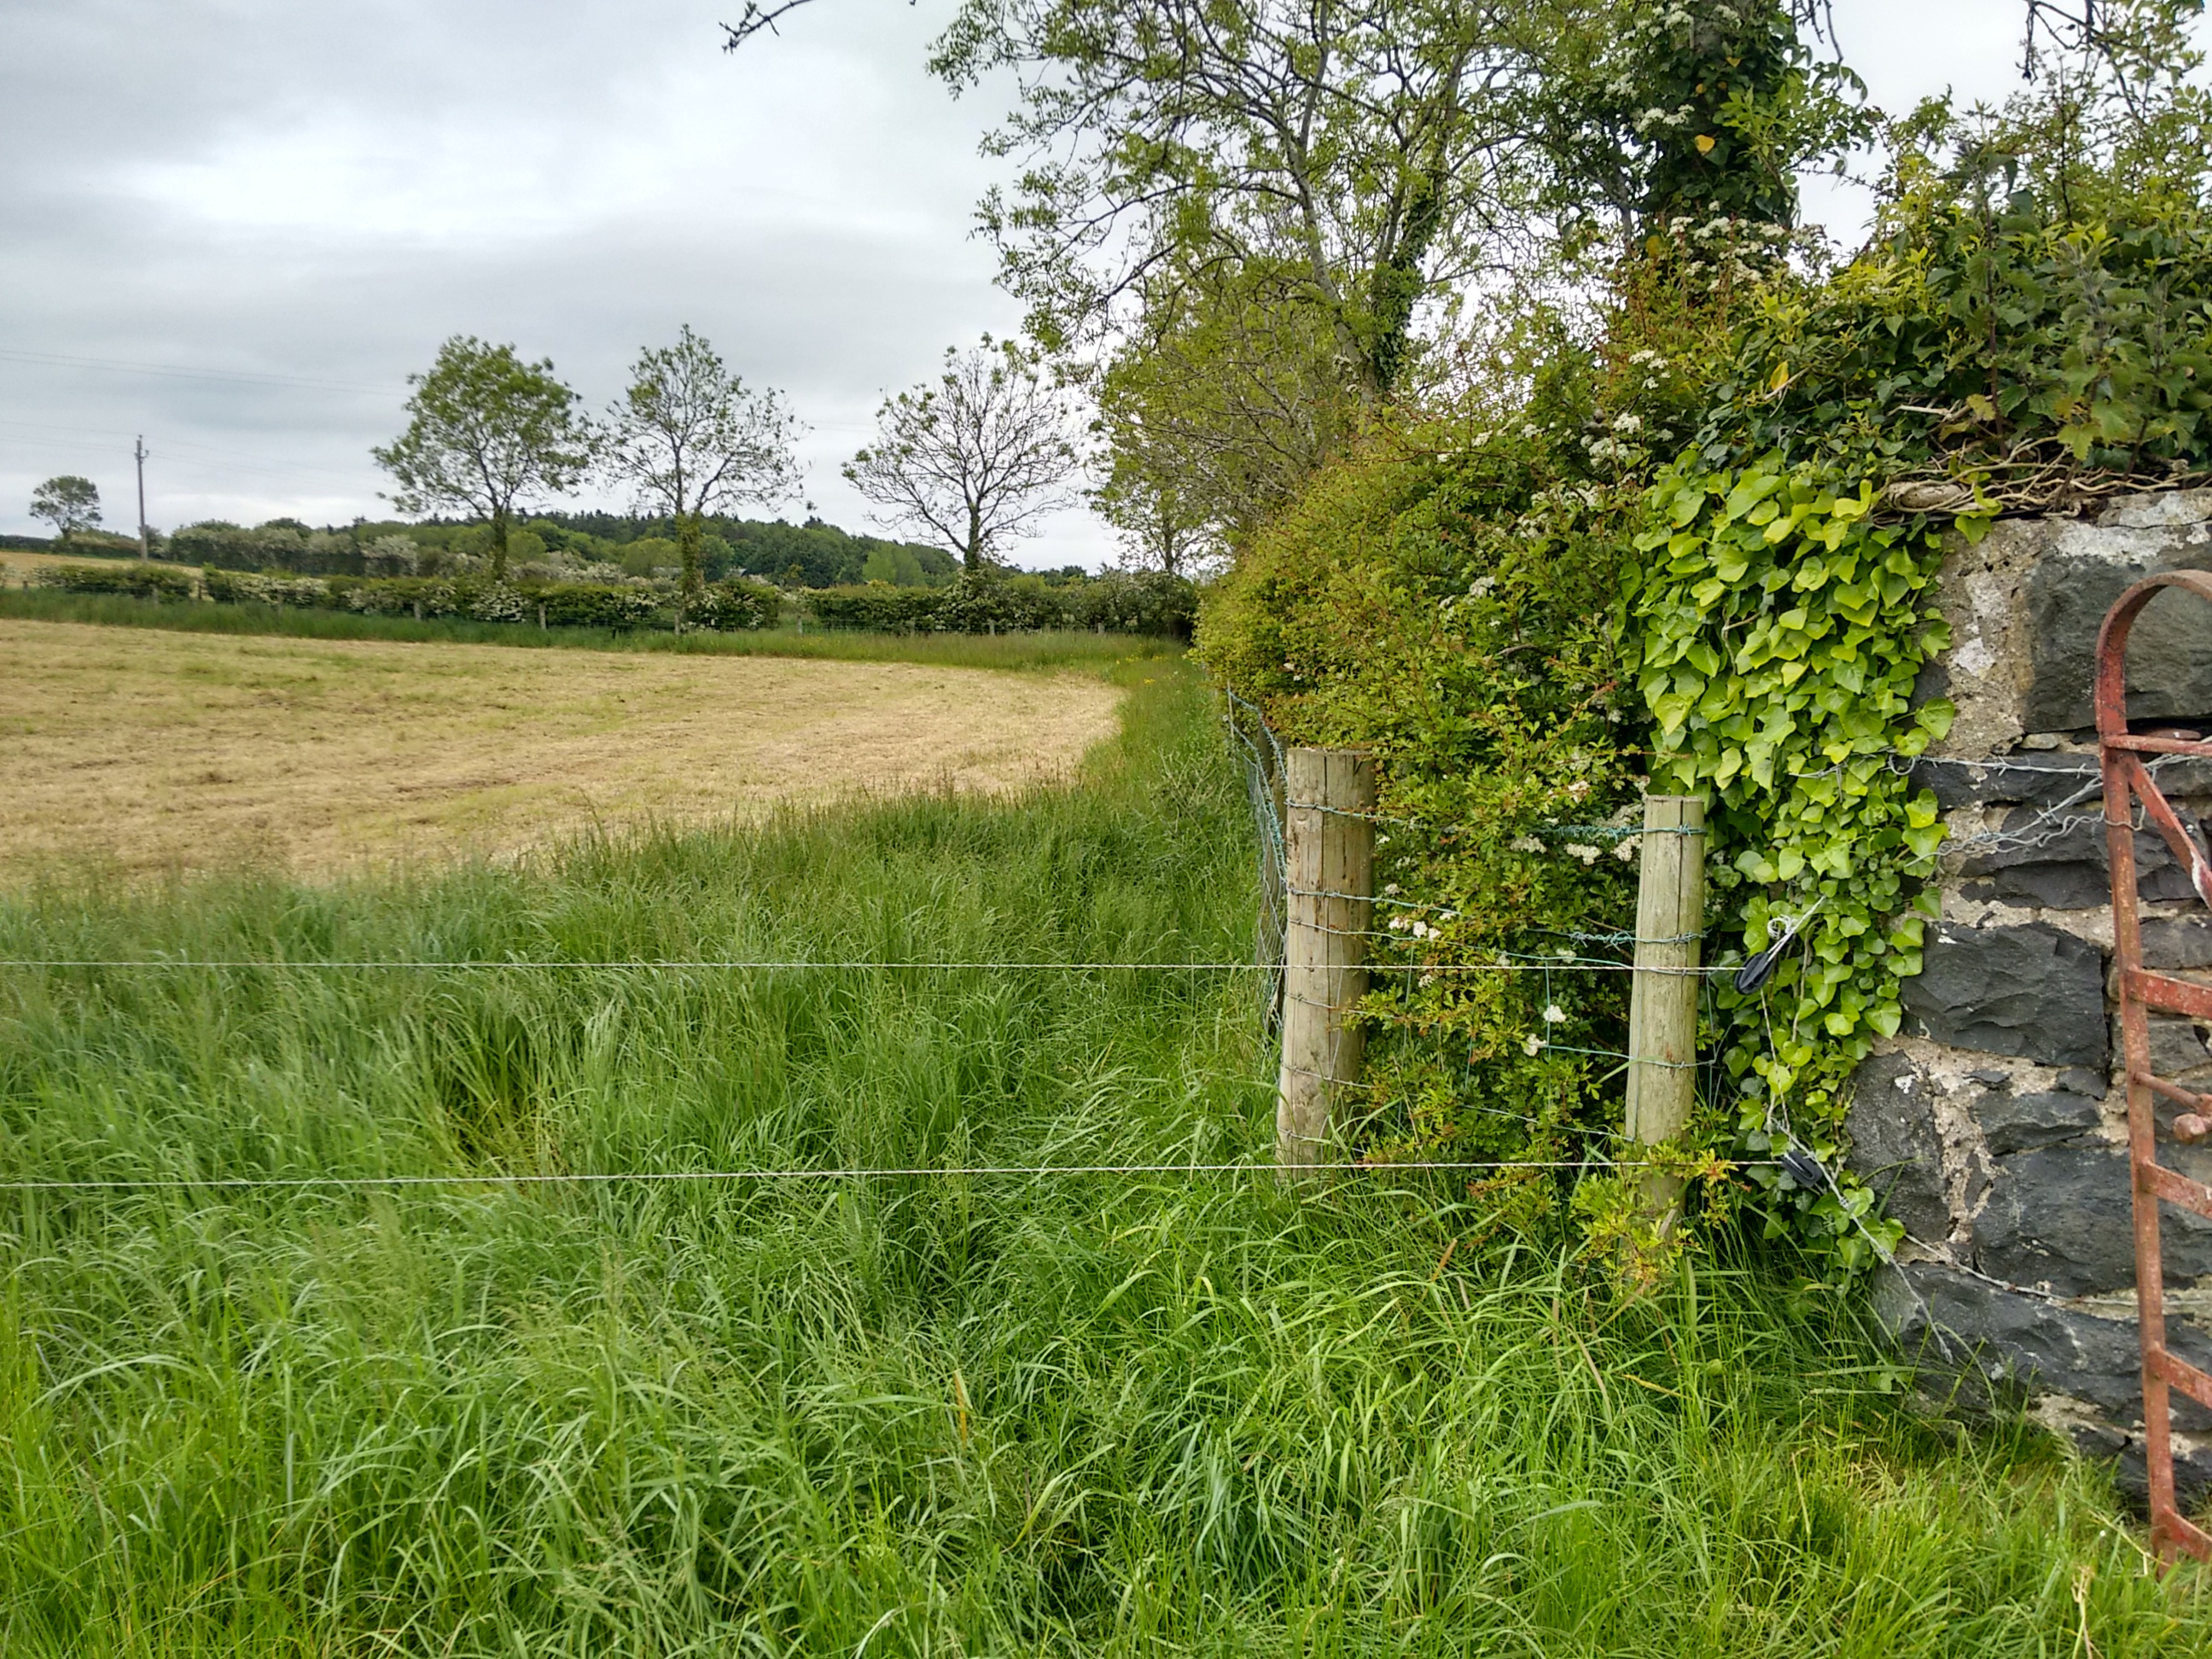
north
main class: Grassland
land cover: Grassland without tree/shrub cover
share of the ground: > 75 %
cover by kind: herbaceous plants 100 %
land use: Agriculture (excluding fallow land and kitchen gardens)
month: June
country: GB
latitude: 55.1048
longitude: -6.6630
